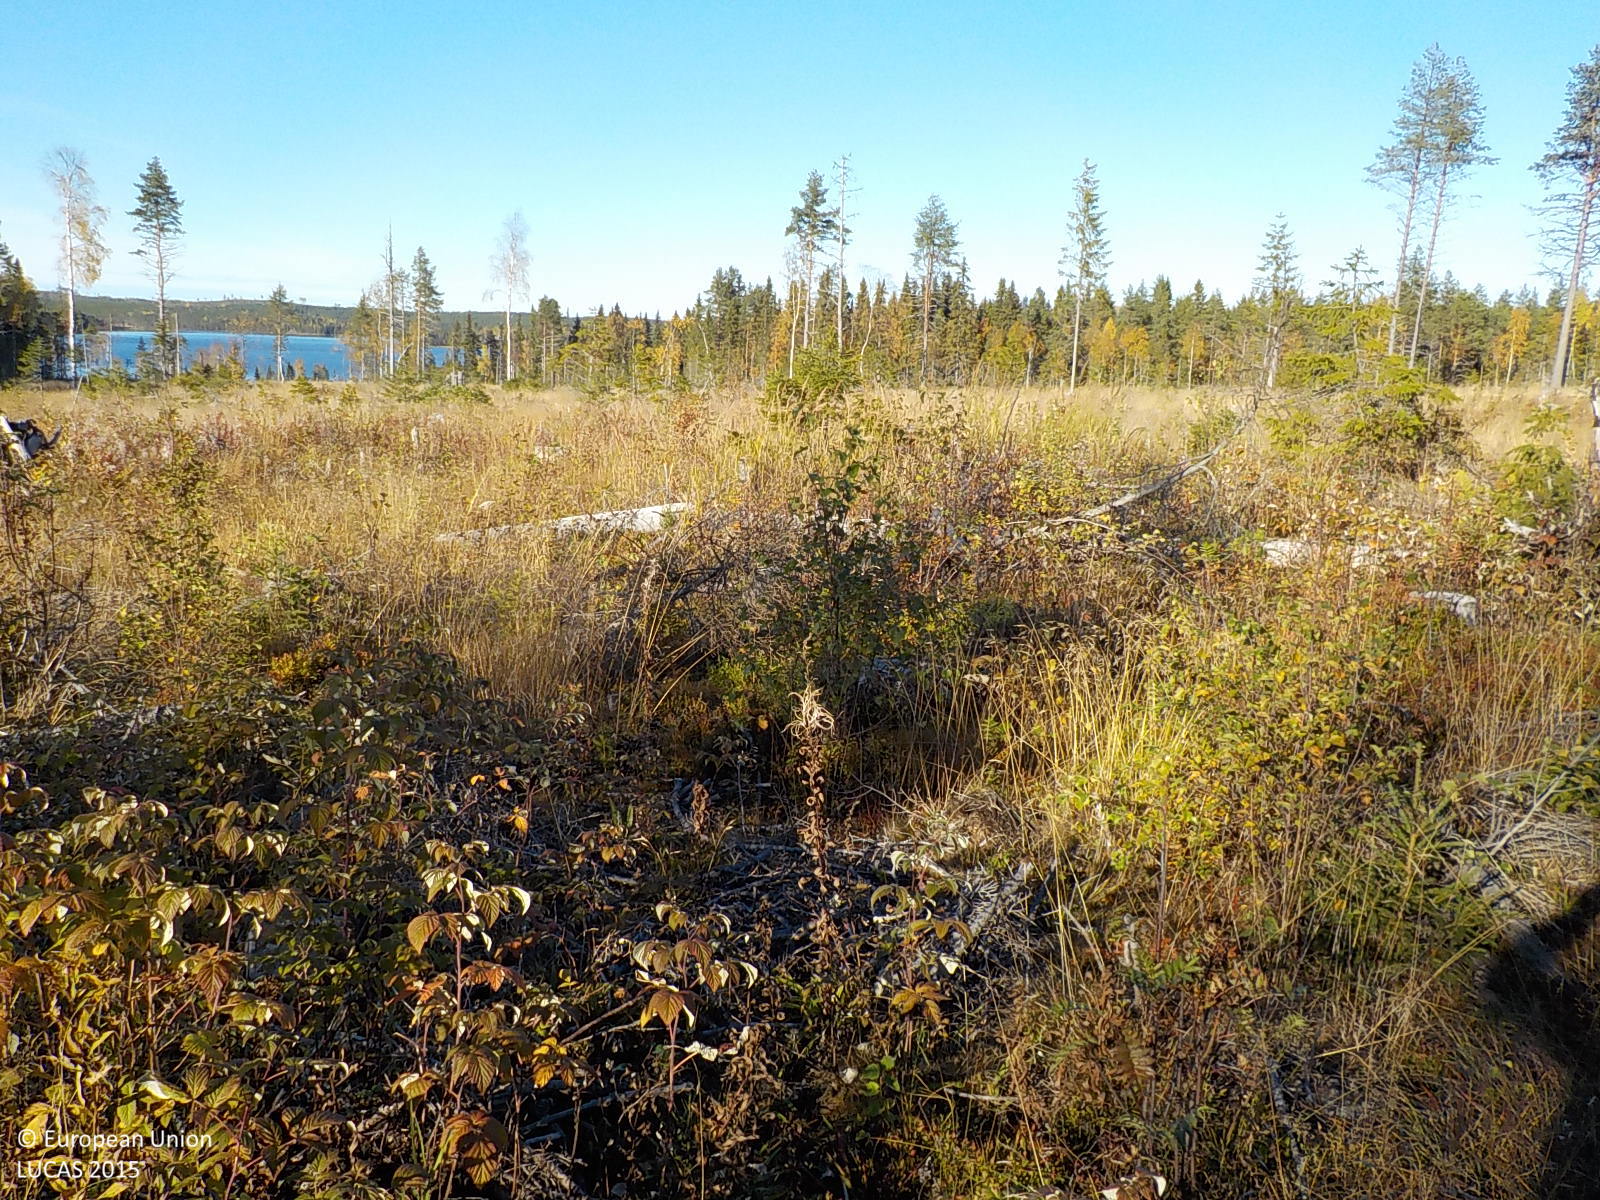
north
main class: Woodland
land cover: Other mixed woodland
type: boreal forest
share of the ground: 10 - 25 %
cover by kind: herbaceous plants 85 %, coniferous forest trees 5 %, broadleaved forest trees 5 %, unconsolidated bare surface 5 %
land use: Forestry
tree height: < 5 m
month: September
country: SE
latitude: 63.4703
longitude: 17.2583
